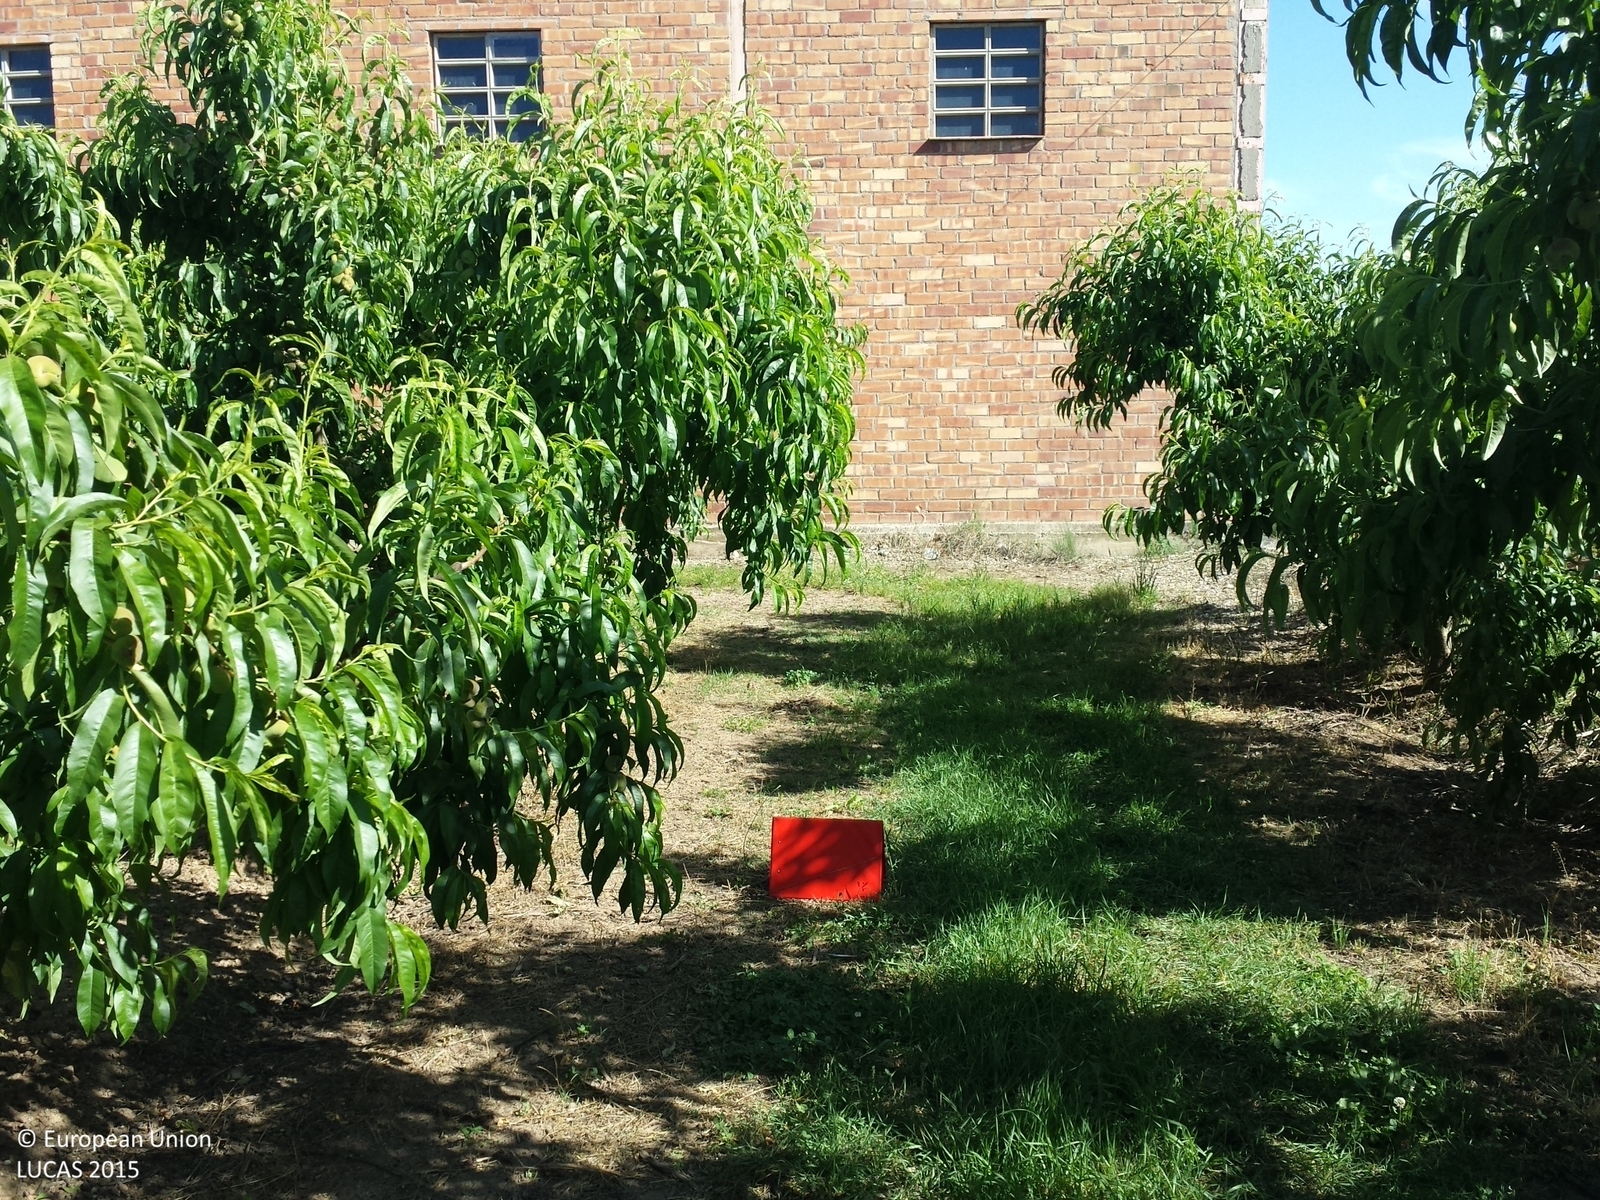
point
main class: Cropland
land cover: Other fruit trees and berries
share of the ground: 25 - 50 %
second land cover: Grassland without tree/shrub cover
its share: 50 - 75 %
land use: Agriculture (excluding fallow land and kitchen gardens)
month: May
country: ES
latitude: 41.6355
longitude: 0.6119
